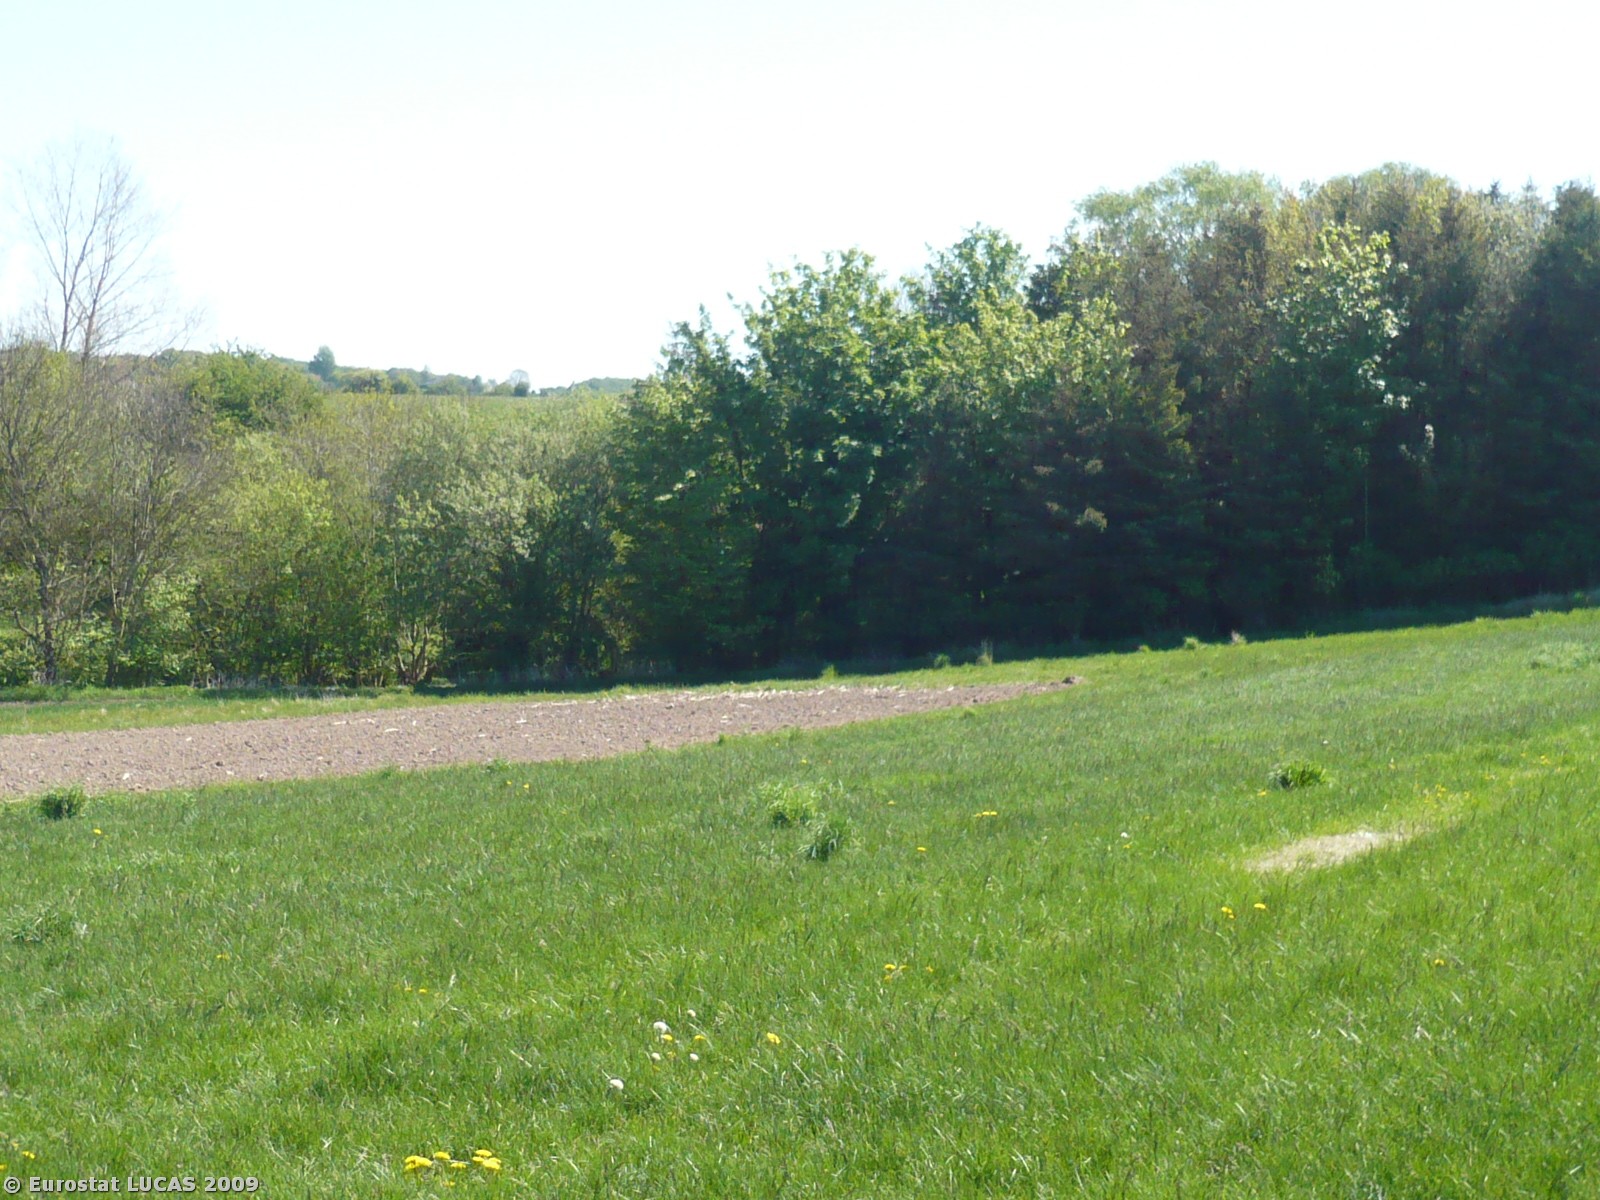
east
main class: Grassland
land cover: Grassland without tree/shrub cover
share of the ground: > 75 %
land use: Agriculture (excluding fallow land and kitchen gardens)
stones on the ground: < 10 %
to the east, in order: Grassland without tree/shrub cover; Maize; Broadleaved woodland; Tracks; Broadleaved woodland; Rivers and streams; Broadleaved woodland; Grassland without tree/shrub cover; Maize; Grassland with sparse tree/shrub cover; Clovers
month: May
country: DK
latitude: 55.1654
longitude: 11.9922
